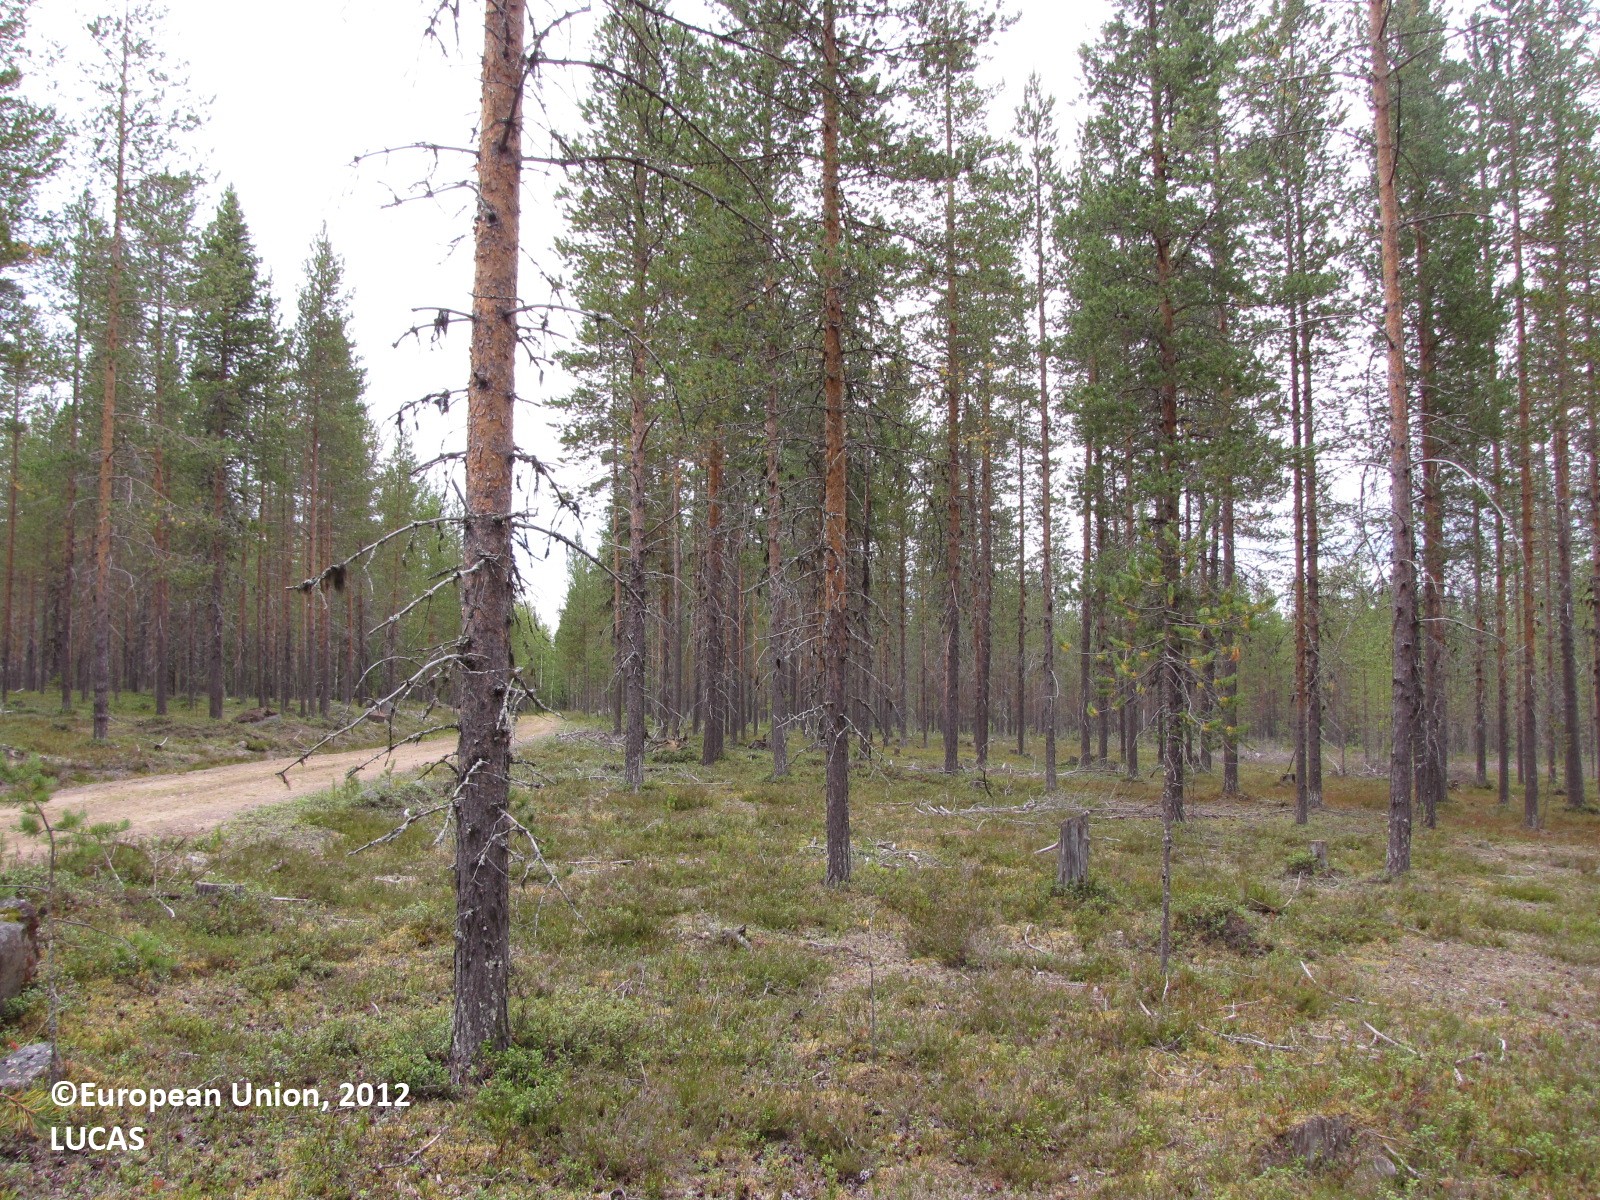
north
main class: Woodland
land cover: Pine dominated coniferous woodland
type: boreal forest
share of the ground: 25 - 50 %
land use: Forestry
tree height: > 5 m
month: August
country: FI
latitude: 67.0502
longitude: 25.1480
